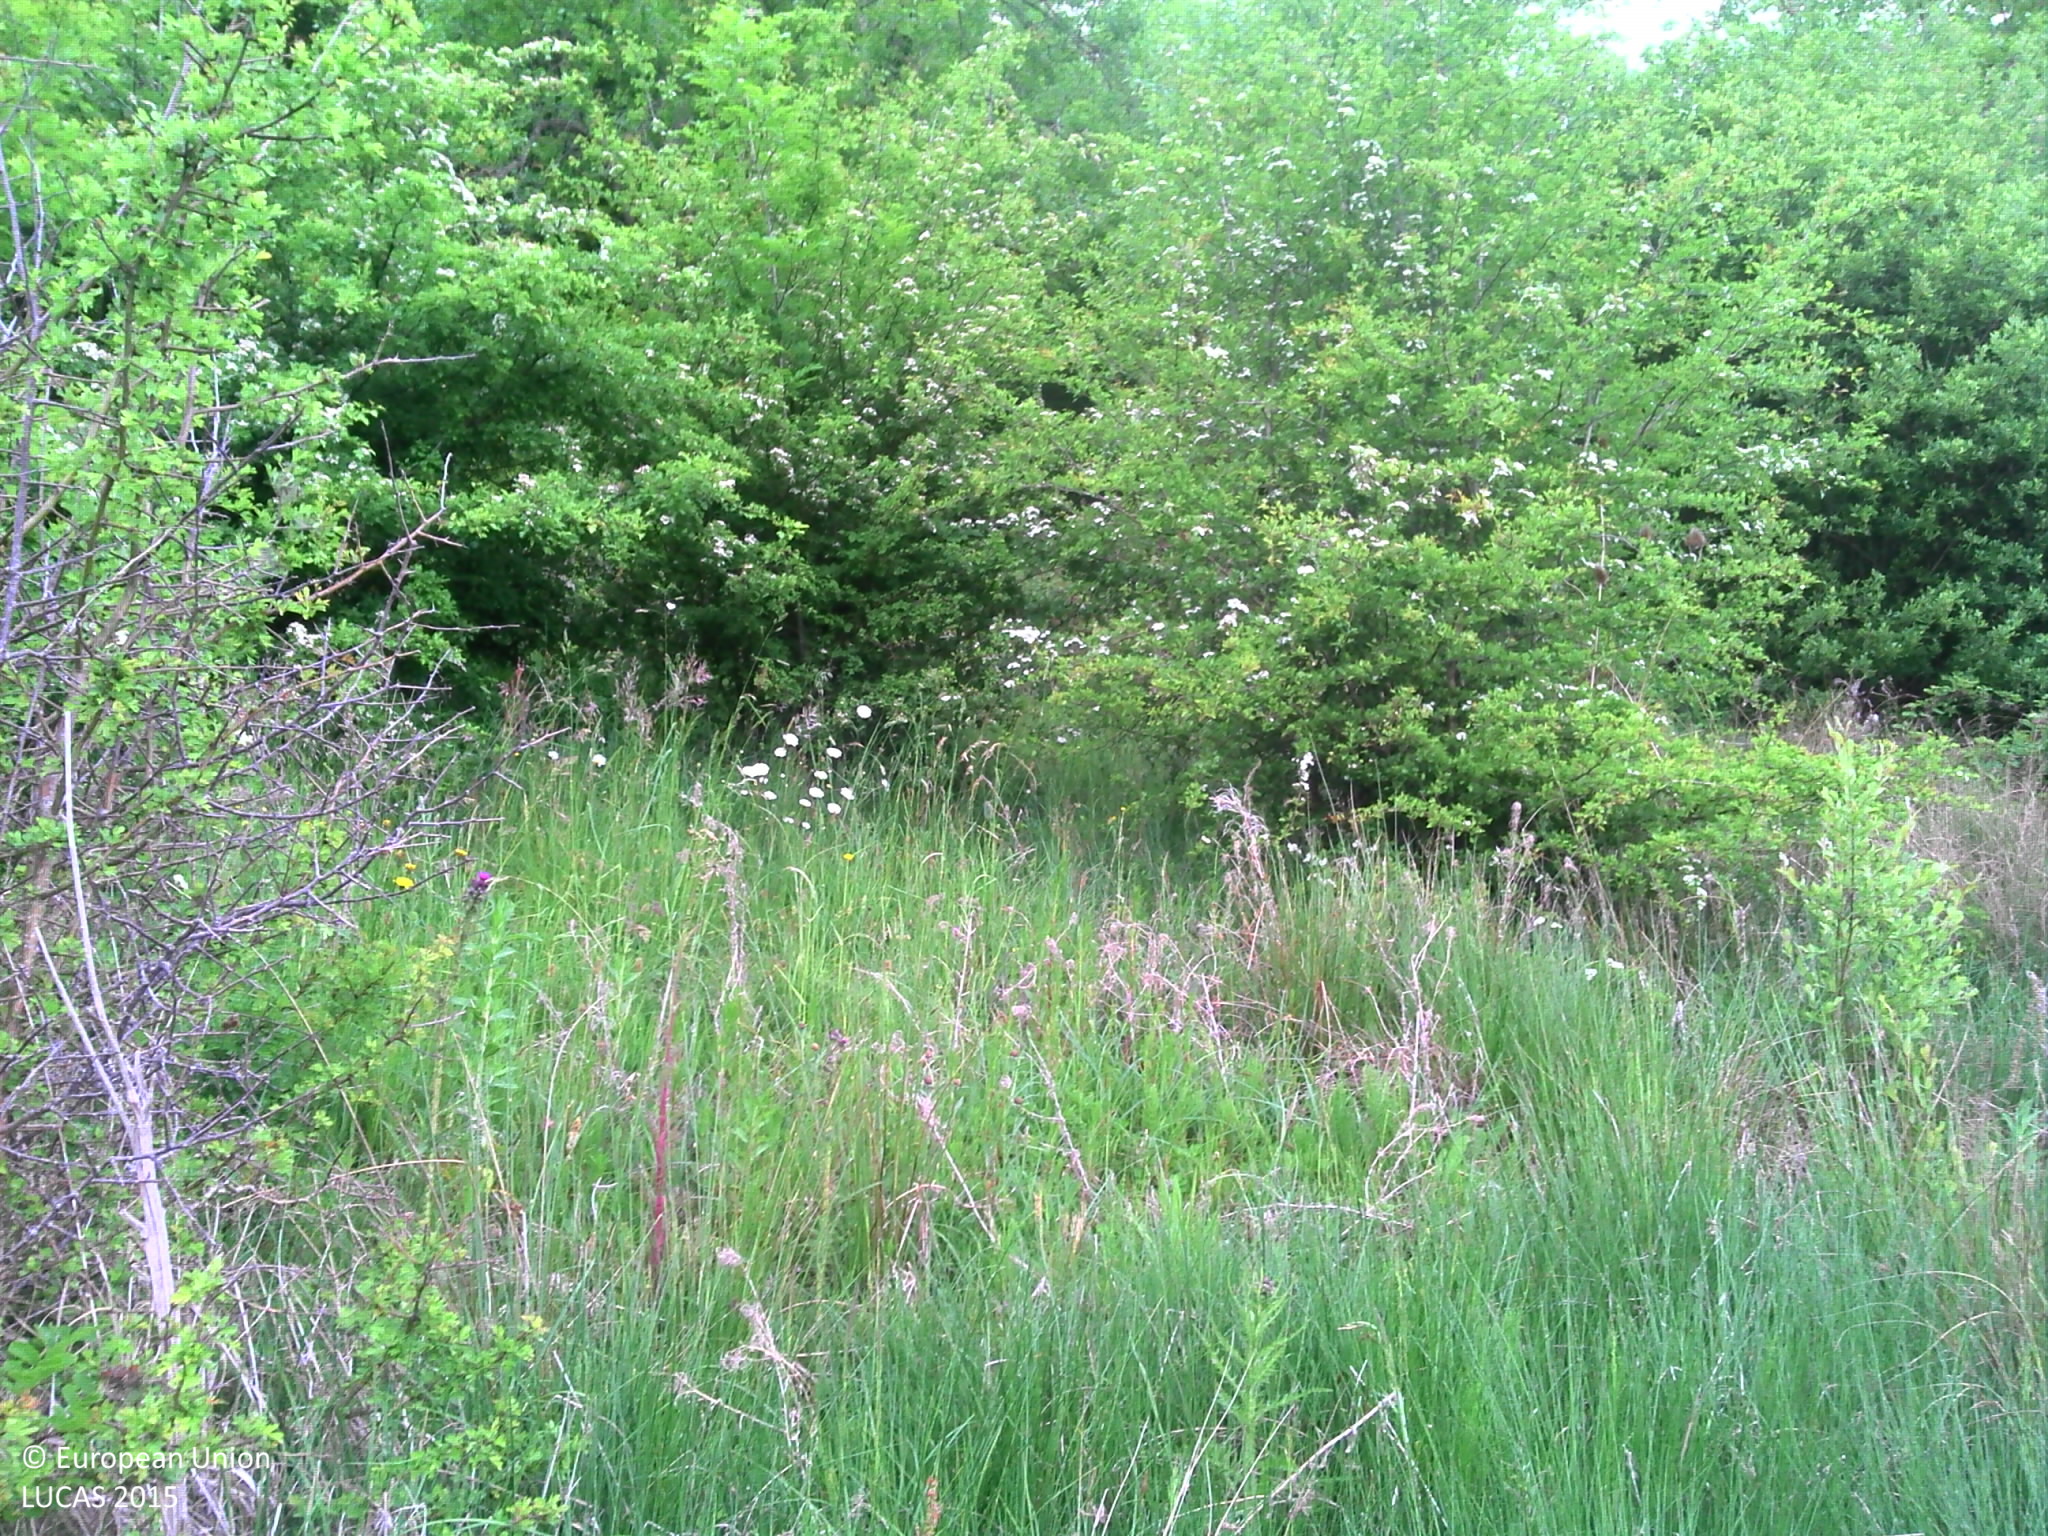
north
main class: Shrubland
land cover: Shrubland without tree cover
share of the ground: > 75 %
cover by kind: herbaceous plants 60 %, shrubs 40 %
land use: Agriculture (excluding fallow land and kitchen gardens)
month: May
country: FR
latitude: 45.2789
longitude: 3.1049
